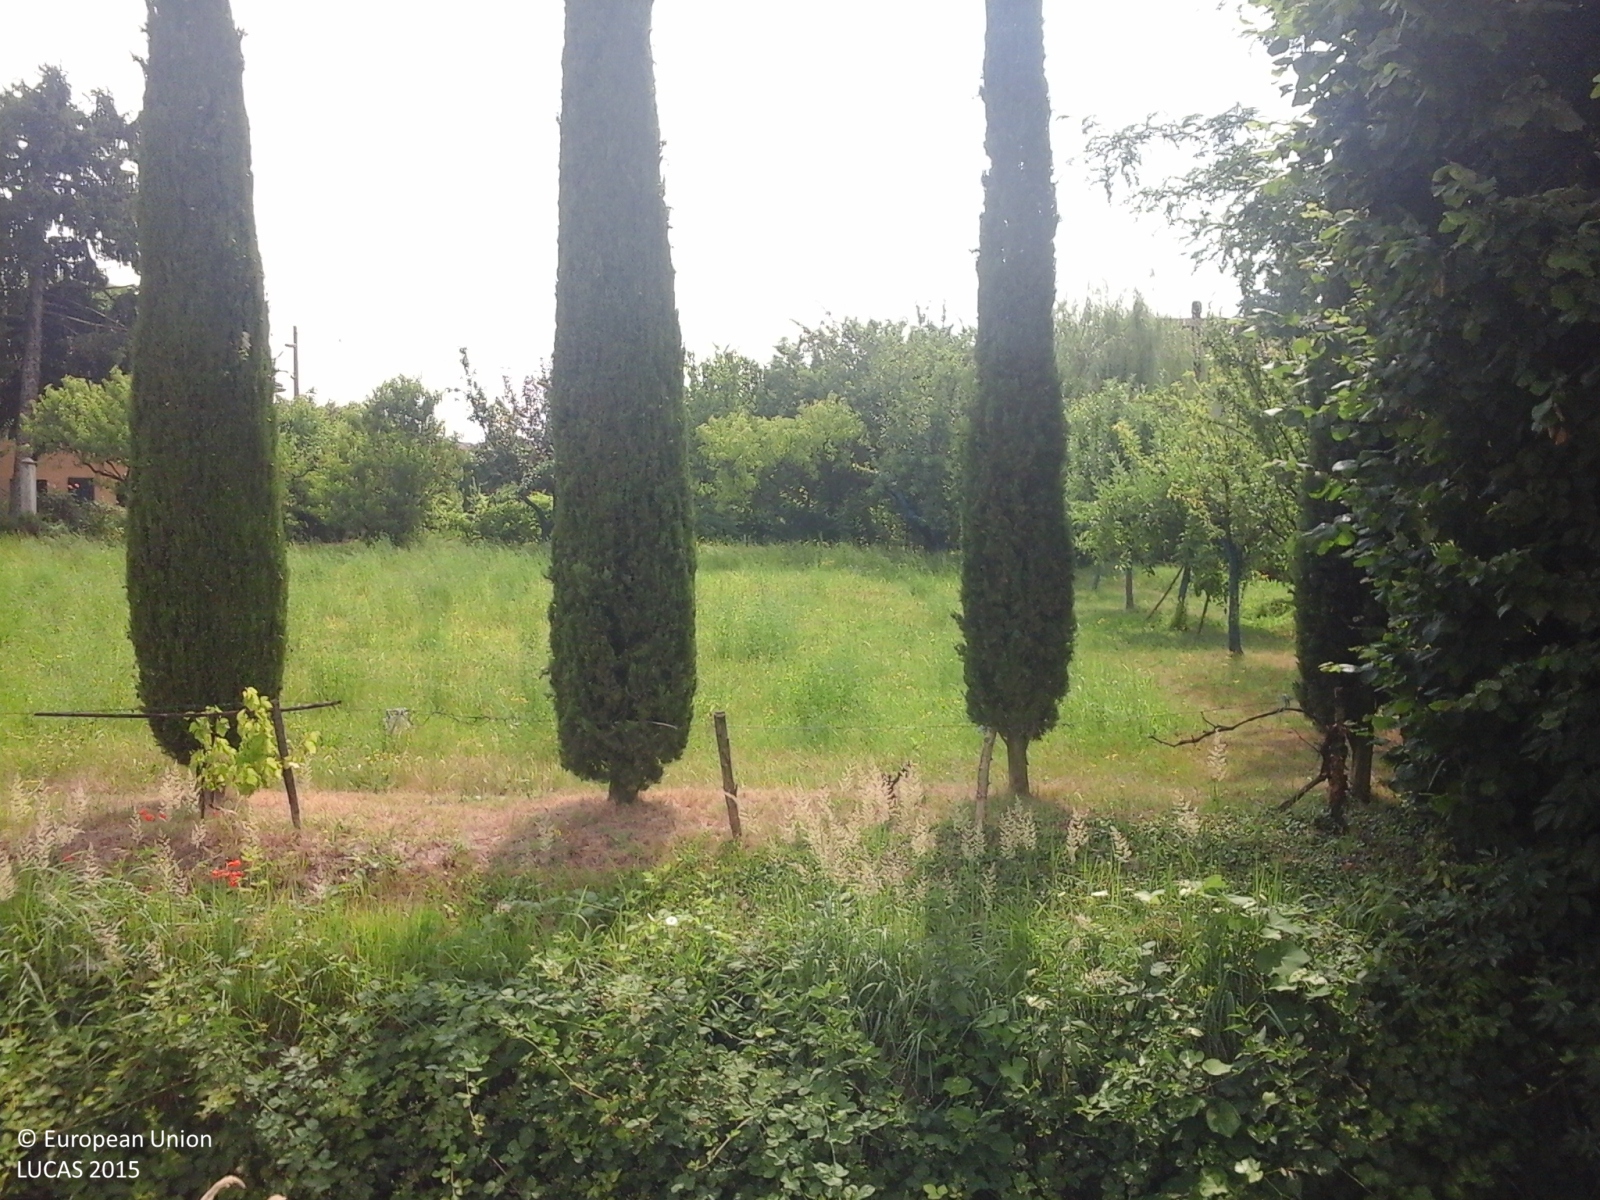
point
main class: Grassland
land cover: Grassland without tree/shrub cover
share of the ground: > 75 %
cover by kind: herbaceous plants 100 %
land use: Agriculture (excluding fallow land and kitchen gardens)
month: June
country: IT
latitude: 45.1190
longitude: 8.7946
